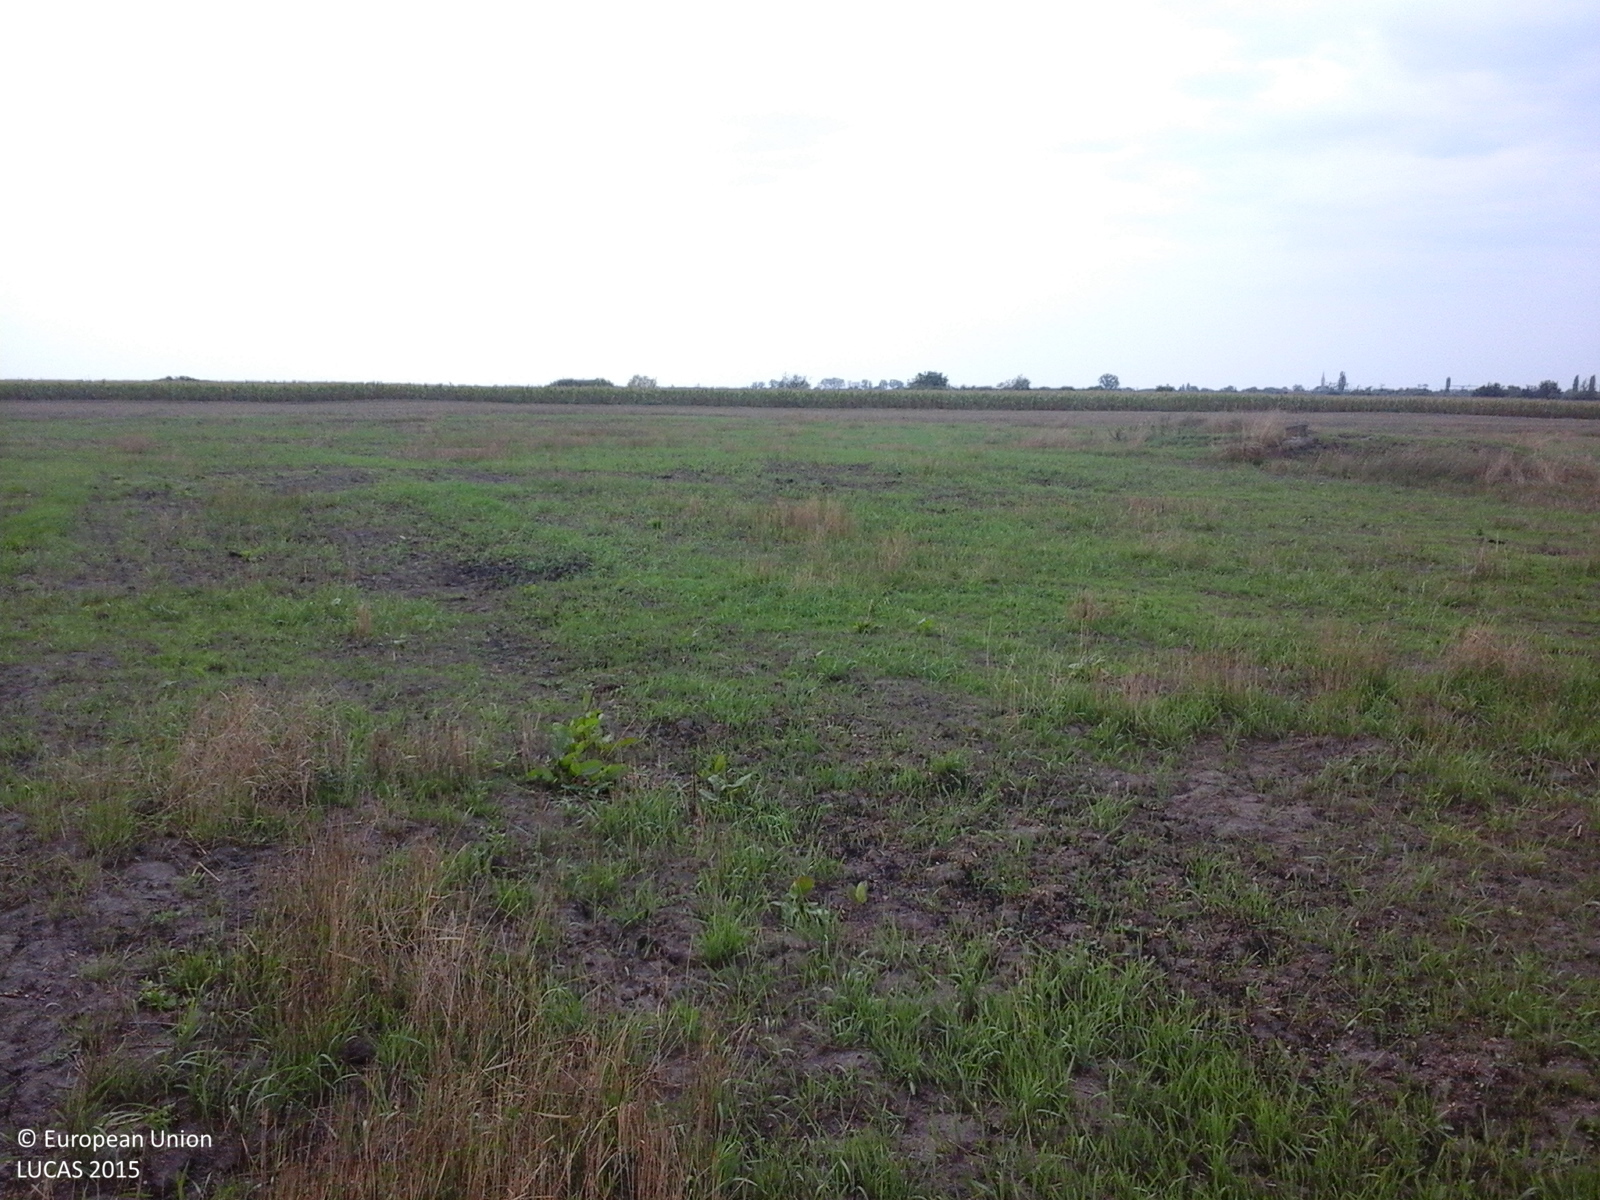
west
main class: Cropland
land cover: Durum wheat
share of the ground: 10 - 25 %
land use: Agriculture (excluding fallow land and kitchen gardens)
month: August
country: RO
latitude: 46.3758
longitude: 21.5696
